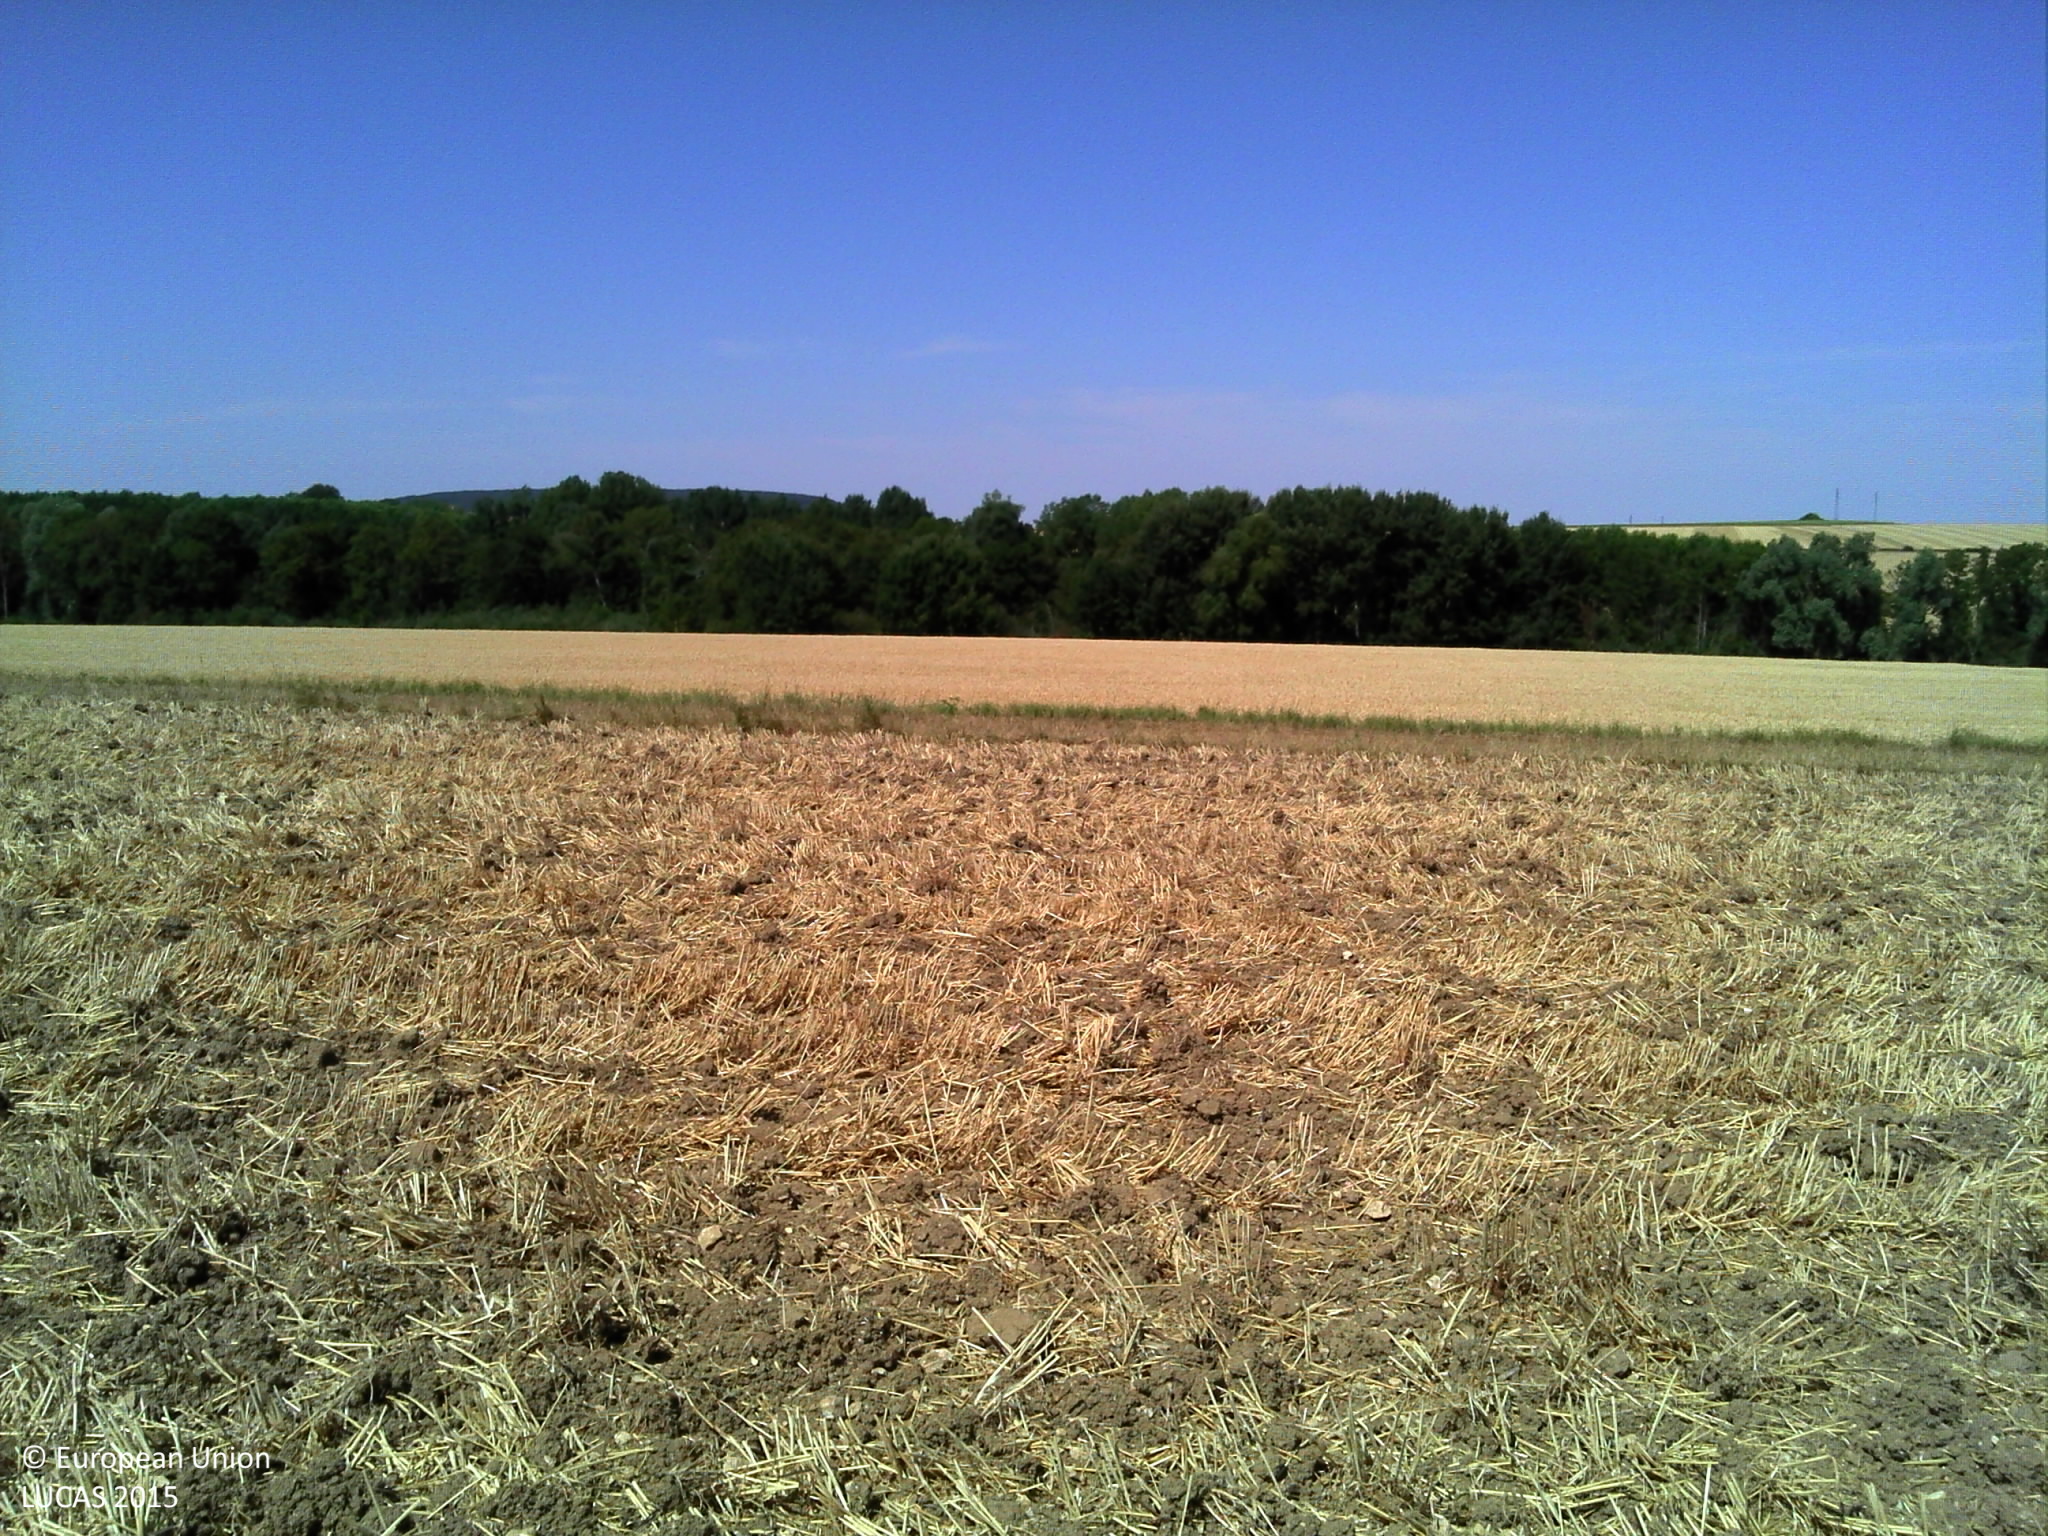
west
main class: Cropland
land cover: Common wheat
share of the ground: > 75 %
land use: Agriculture (excluding fallow land and kitchen gardens)
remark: Tilled/Sowed
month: August
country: FR
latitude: 47.9384
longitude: 3.4488
